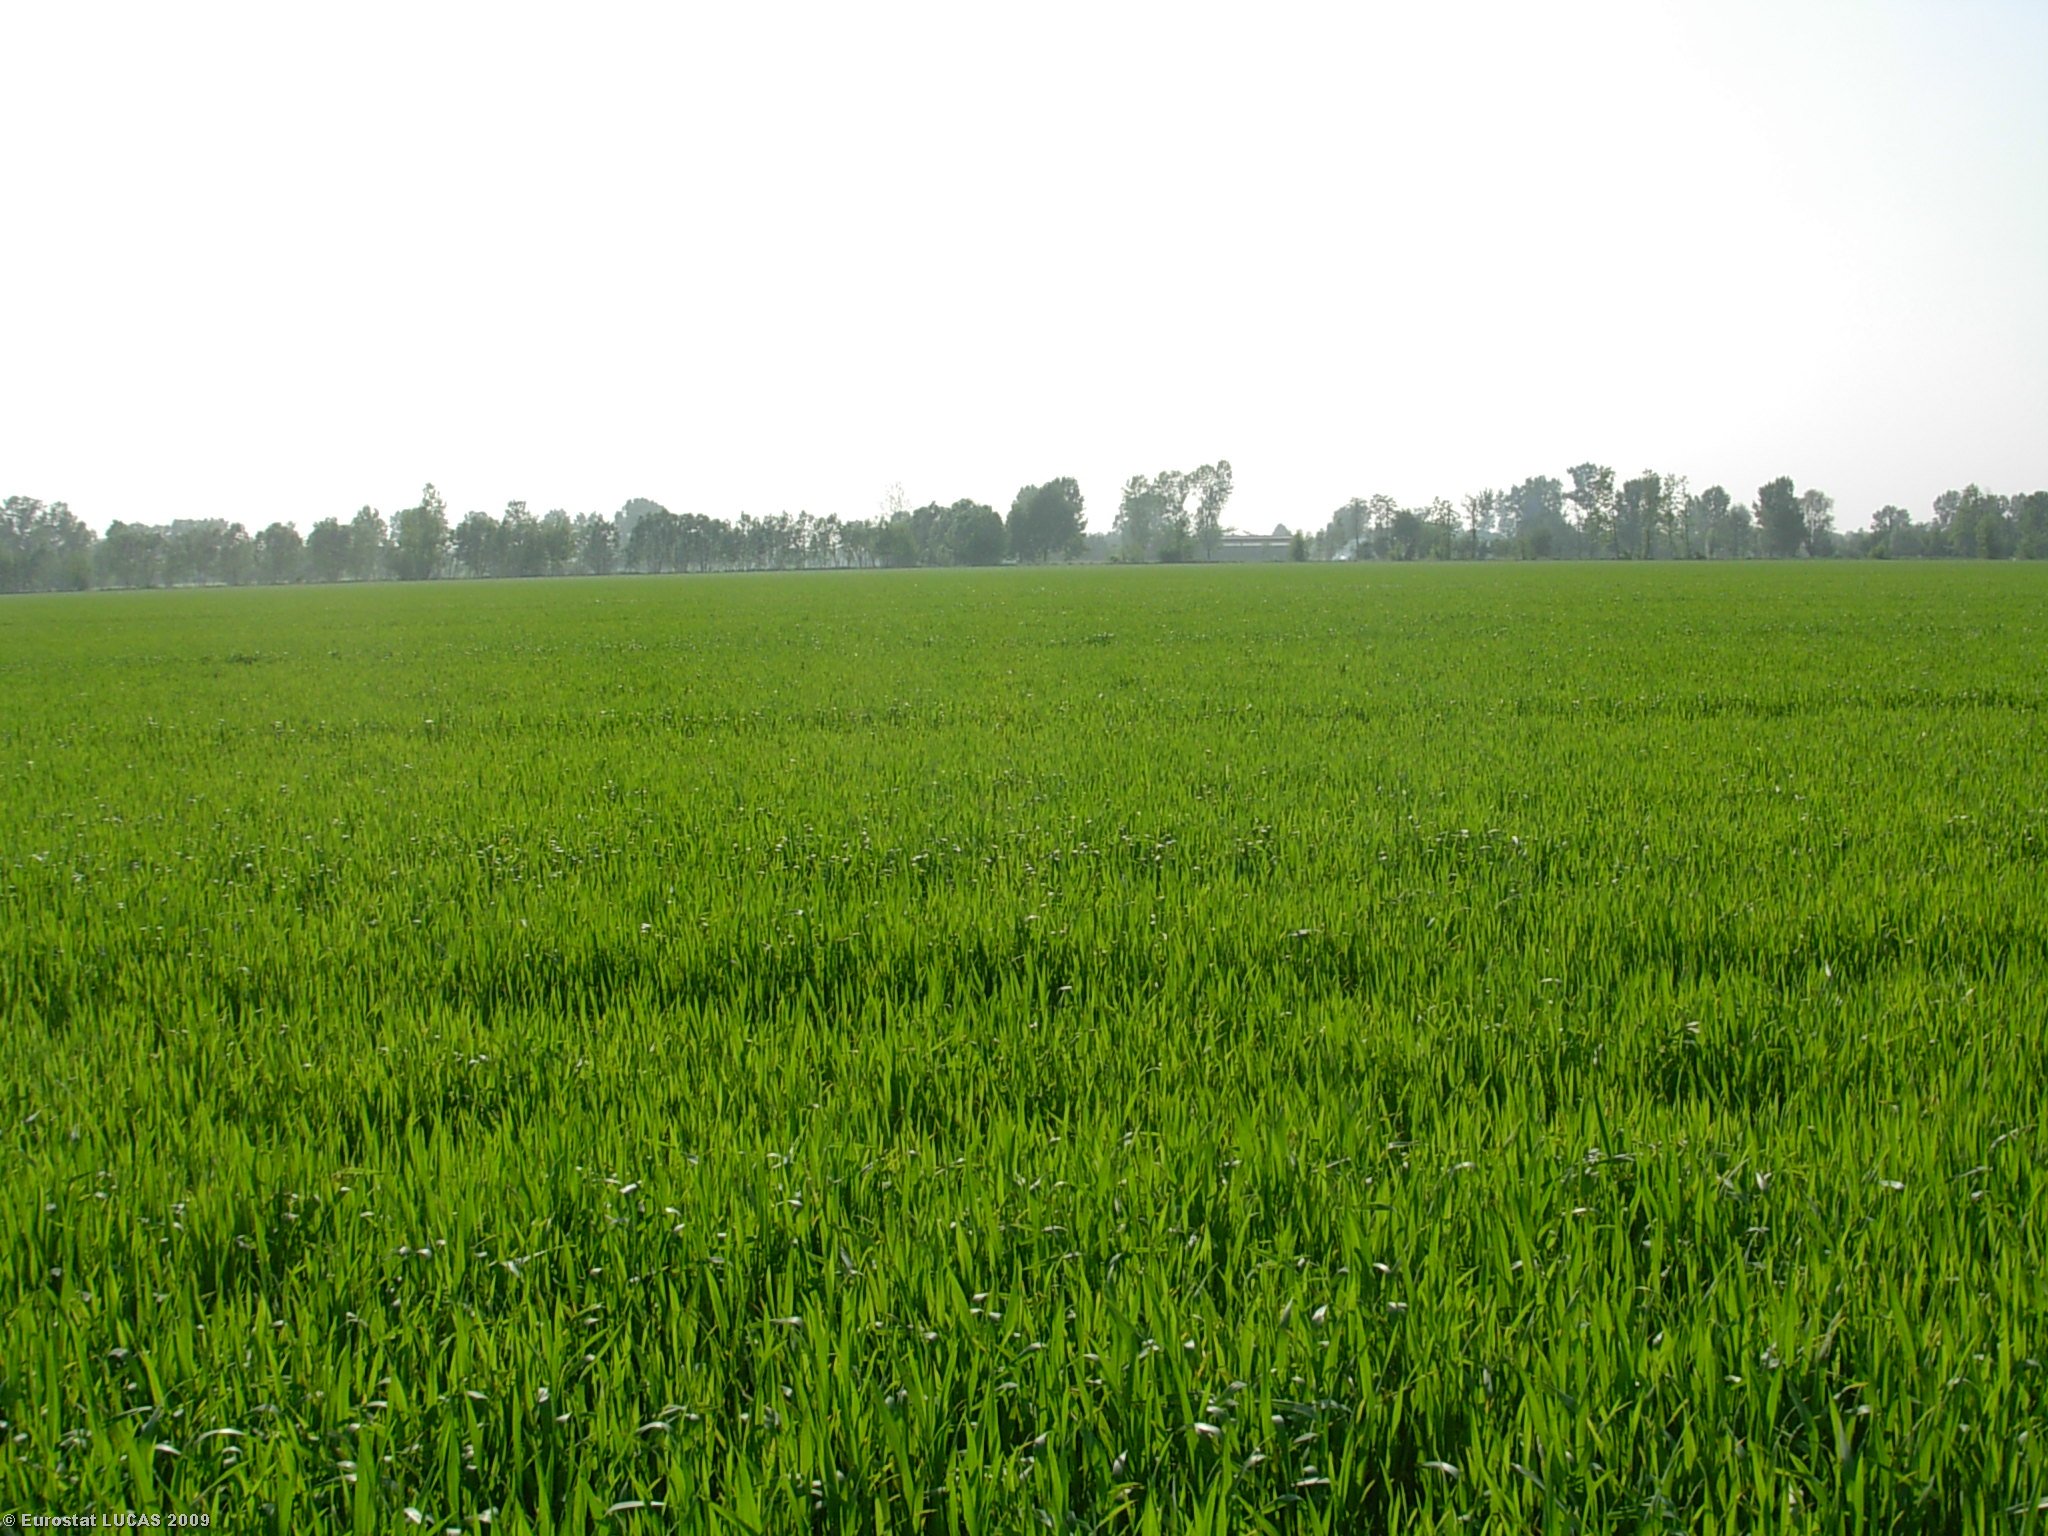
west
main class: Cropland
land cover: Common wheat
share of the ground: > 75 %
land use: Agriculture (excluding fallow land and kitchen gardens)
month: May
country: IT
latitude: 45.2698
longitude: 10.2672
